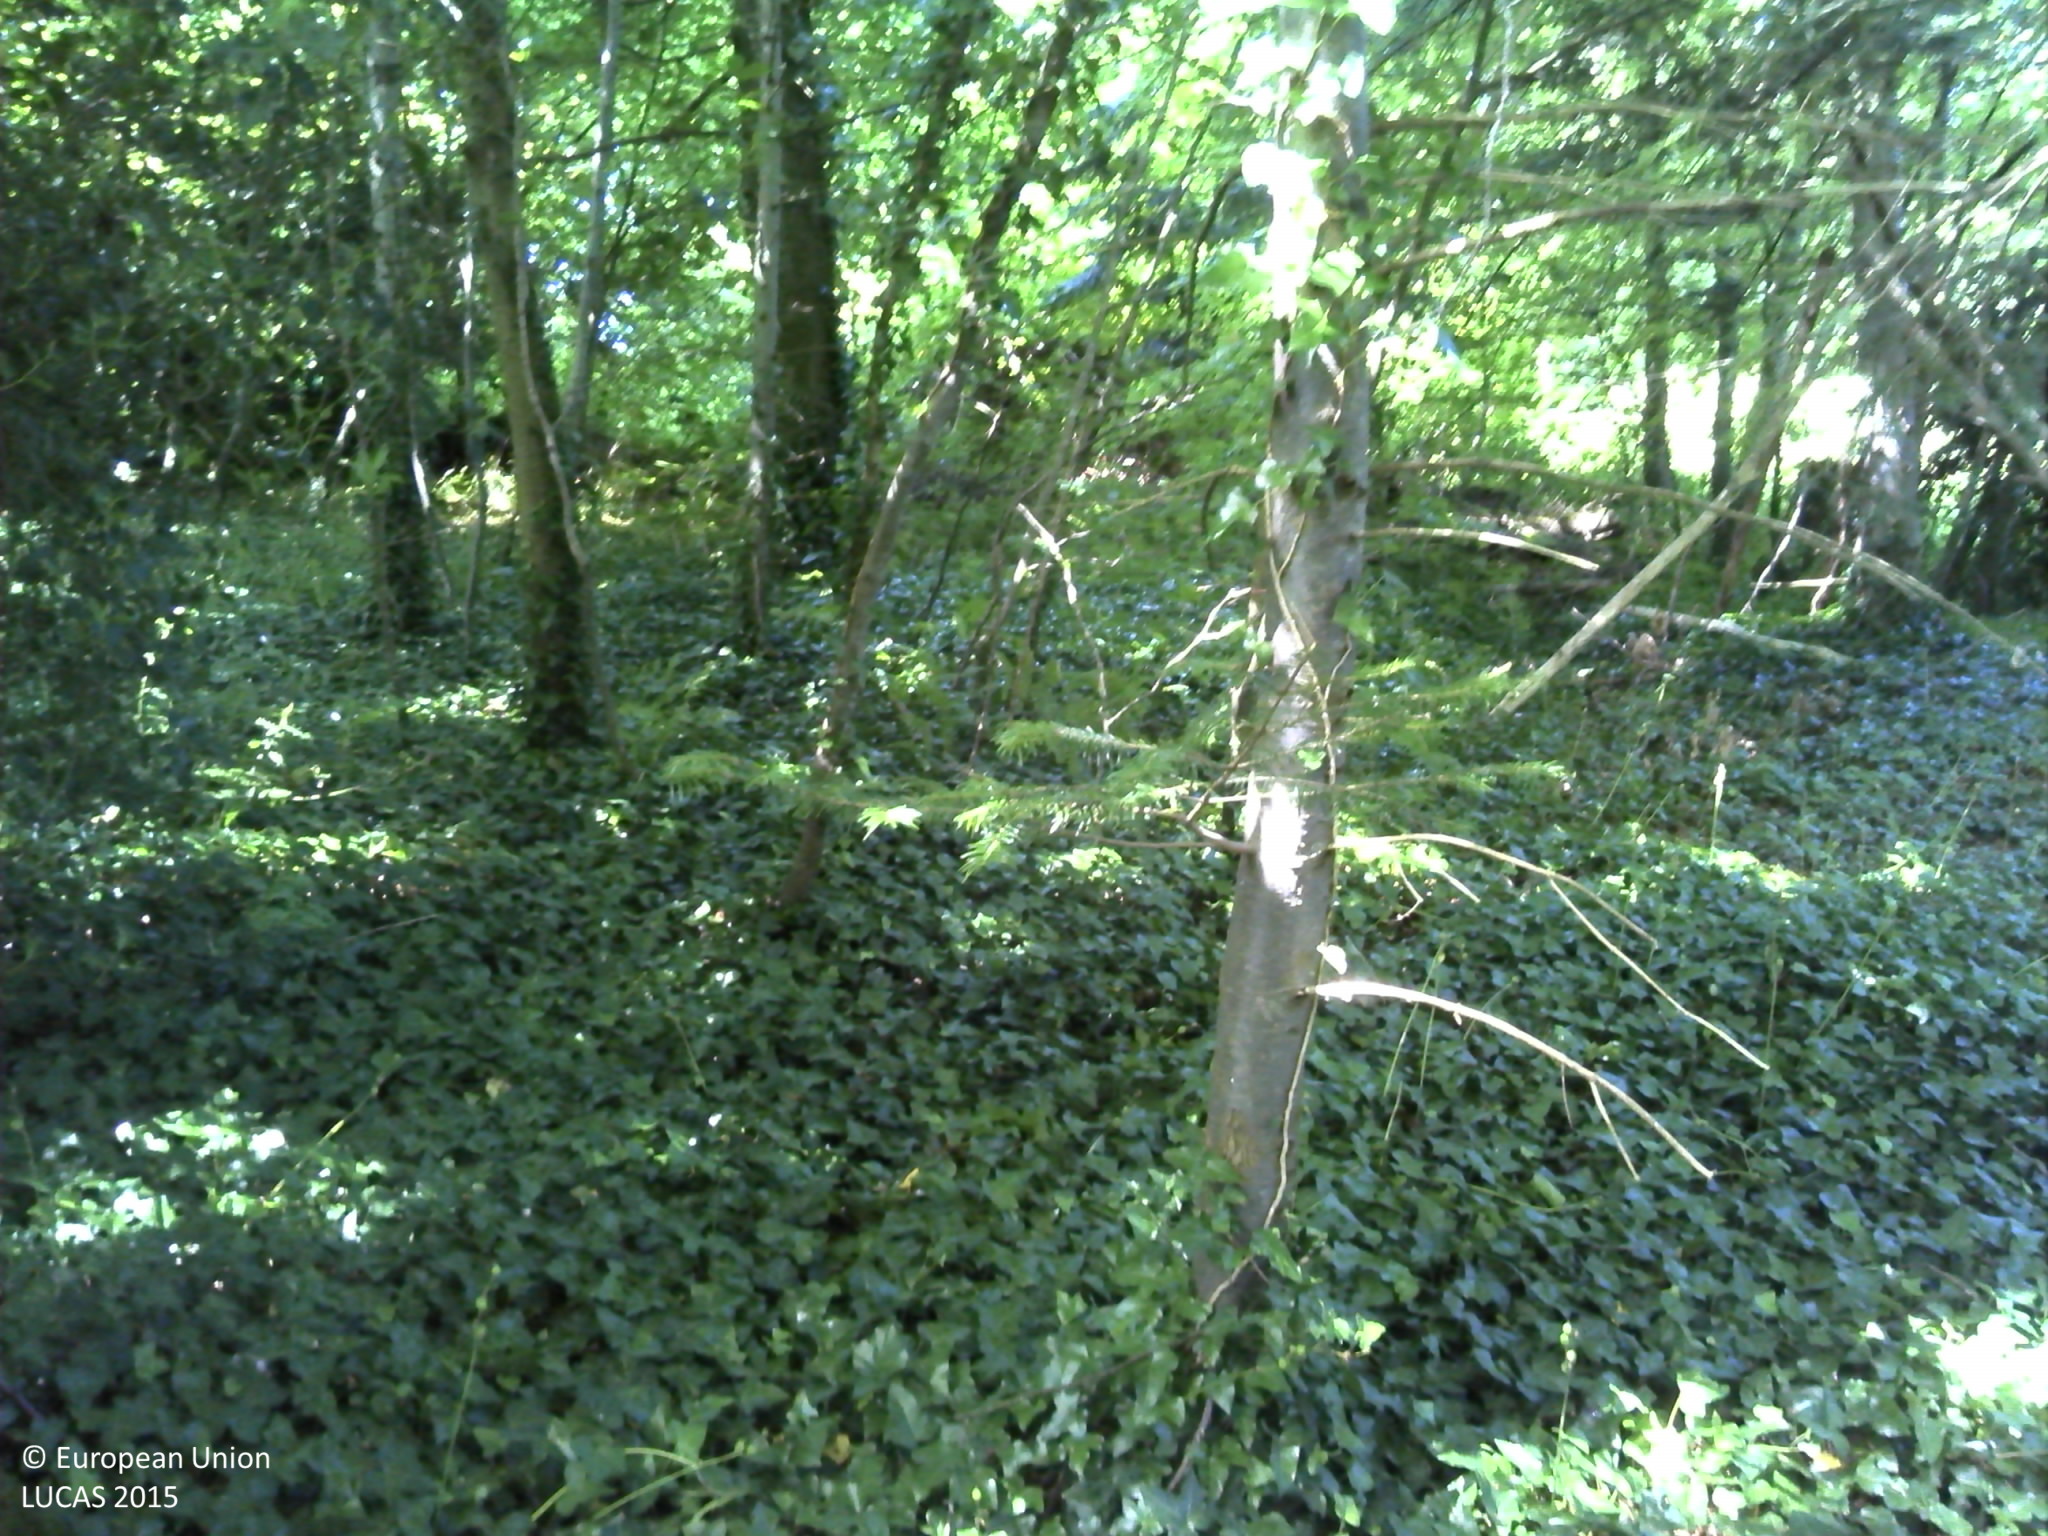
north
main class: Woodland
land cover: Broadleaved woodland
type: beech forest
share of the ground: > 75 %
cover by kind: broadleaved forest trees 85 %, coniferous forest trees 15 %
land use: Amenities, museums, leisure
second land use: Community services
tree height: > 5 m
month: June
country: FR
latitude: 48.4258
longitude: -4.5186
